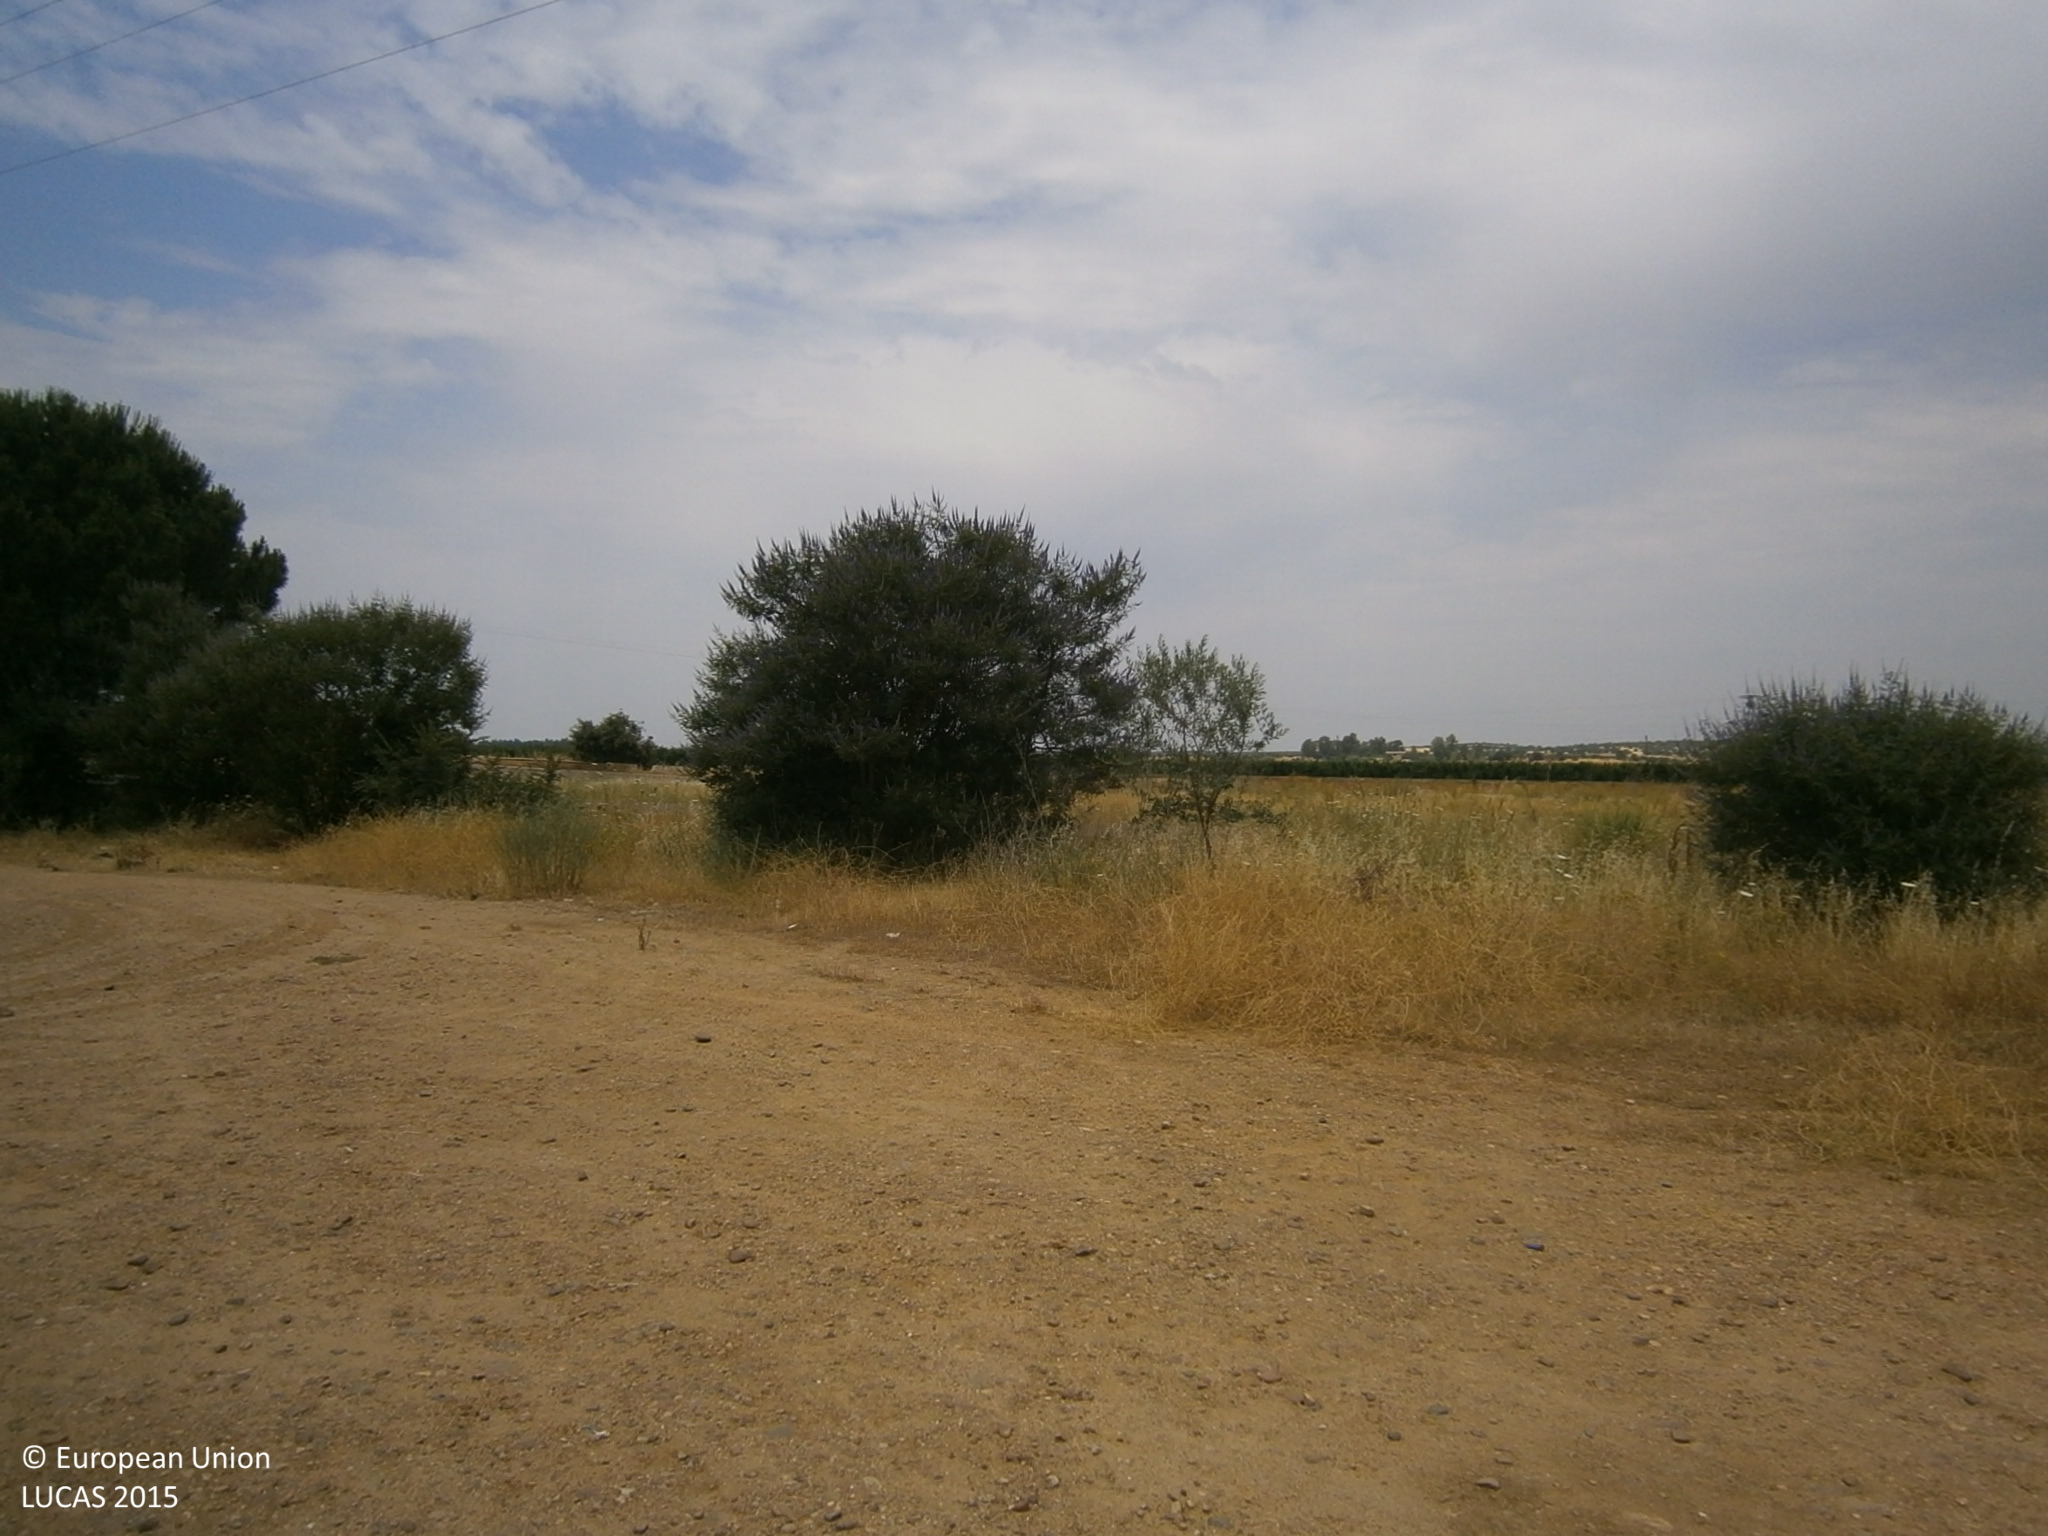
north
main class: Grassland
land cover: Grassland without tree/shrub cover
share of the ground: 25 - 50 %
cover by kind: herbaceous plants 95 %, shrubs 5 %
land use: Abandoned areas
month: June
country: ES
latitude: 38.9155
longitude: -6.4952
